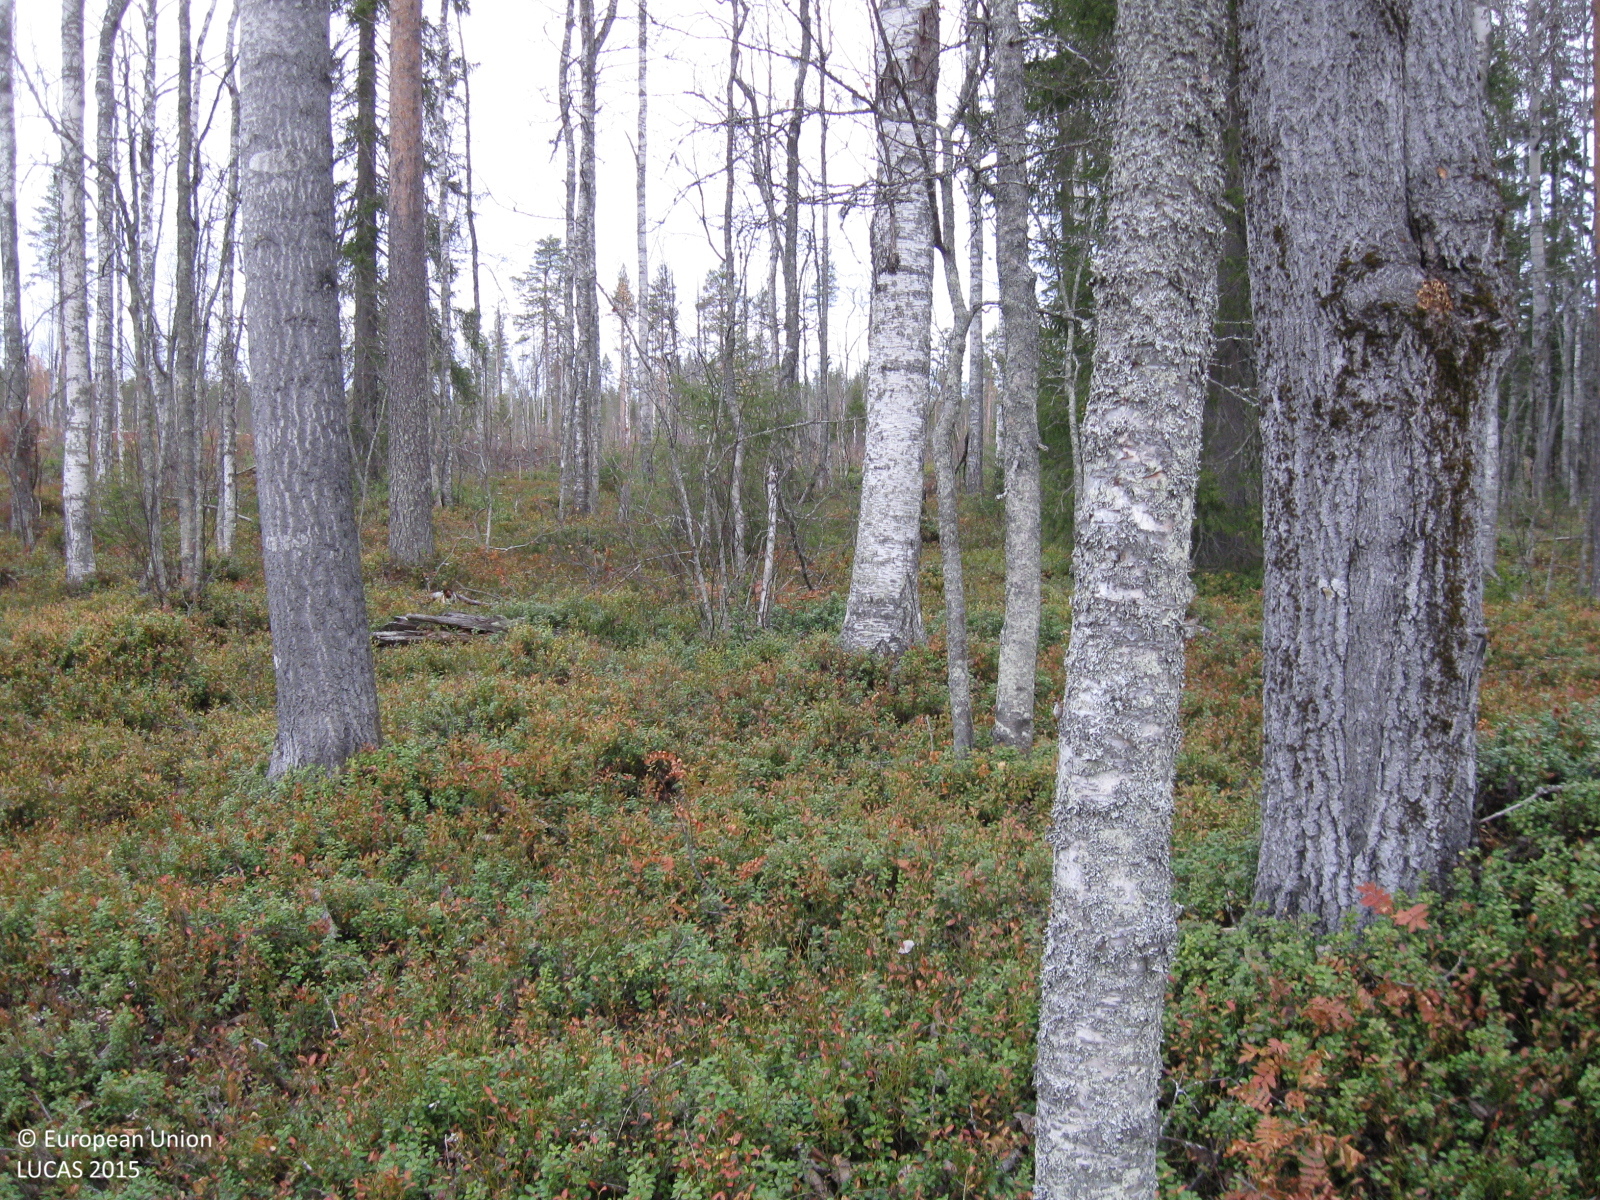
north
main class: Woodland
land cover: Broadleaved woodland
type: non-riverine alder, birch or aspen forest
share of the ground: > 75 %
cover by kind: broadleaved forest trees 75 %, herbaceous plants 10 %, coniferous forest trees 5 %, shrubs 5 %, lichens and mosses 5 %
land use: Forestry
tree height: > 5 m
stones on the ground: < 10 %
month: October
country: SE
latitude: 66.0601
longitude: 22.0980
